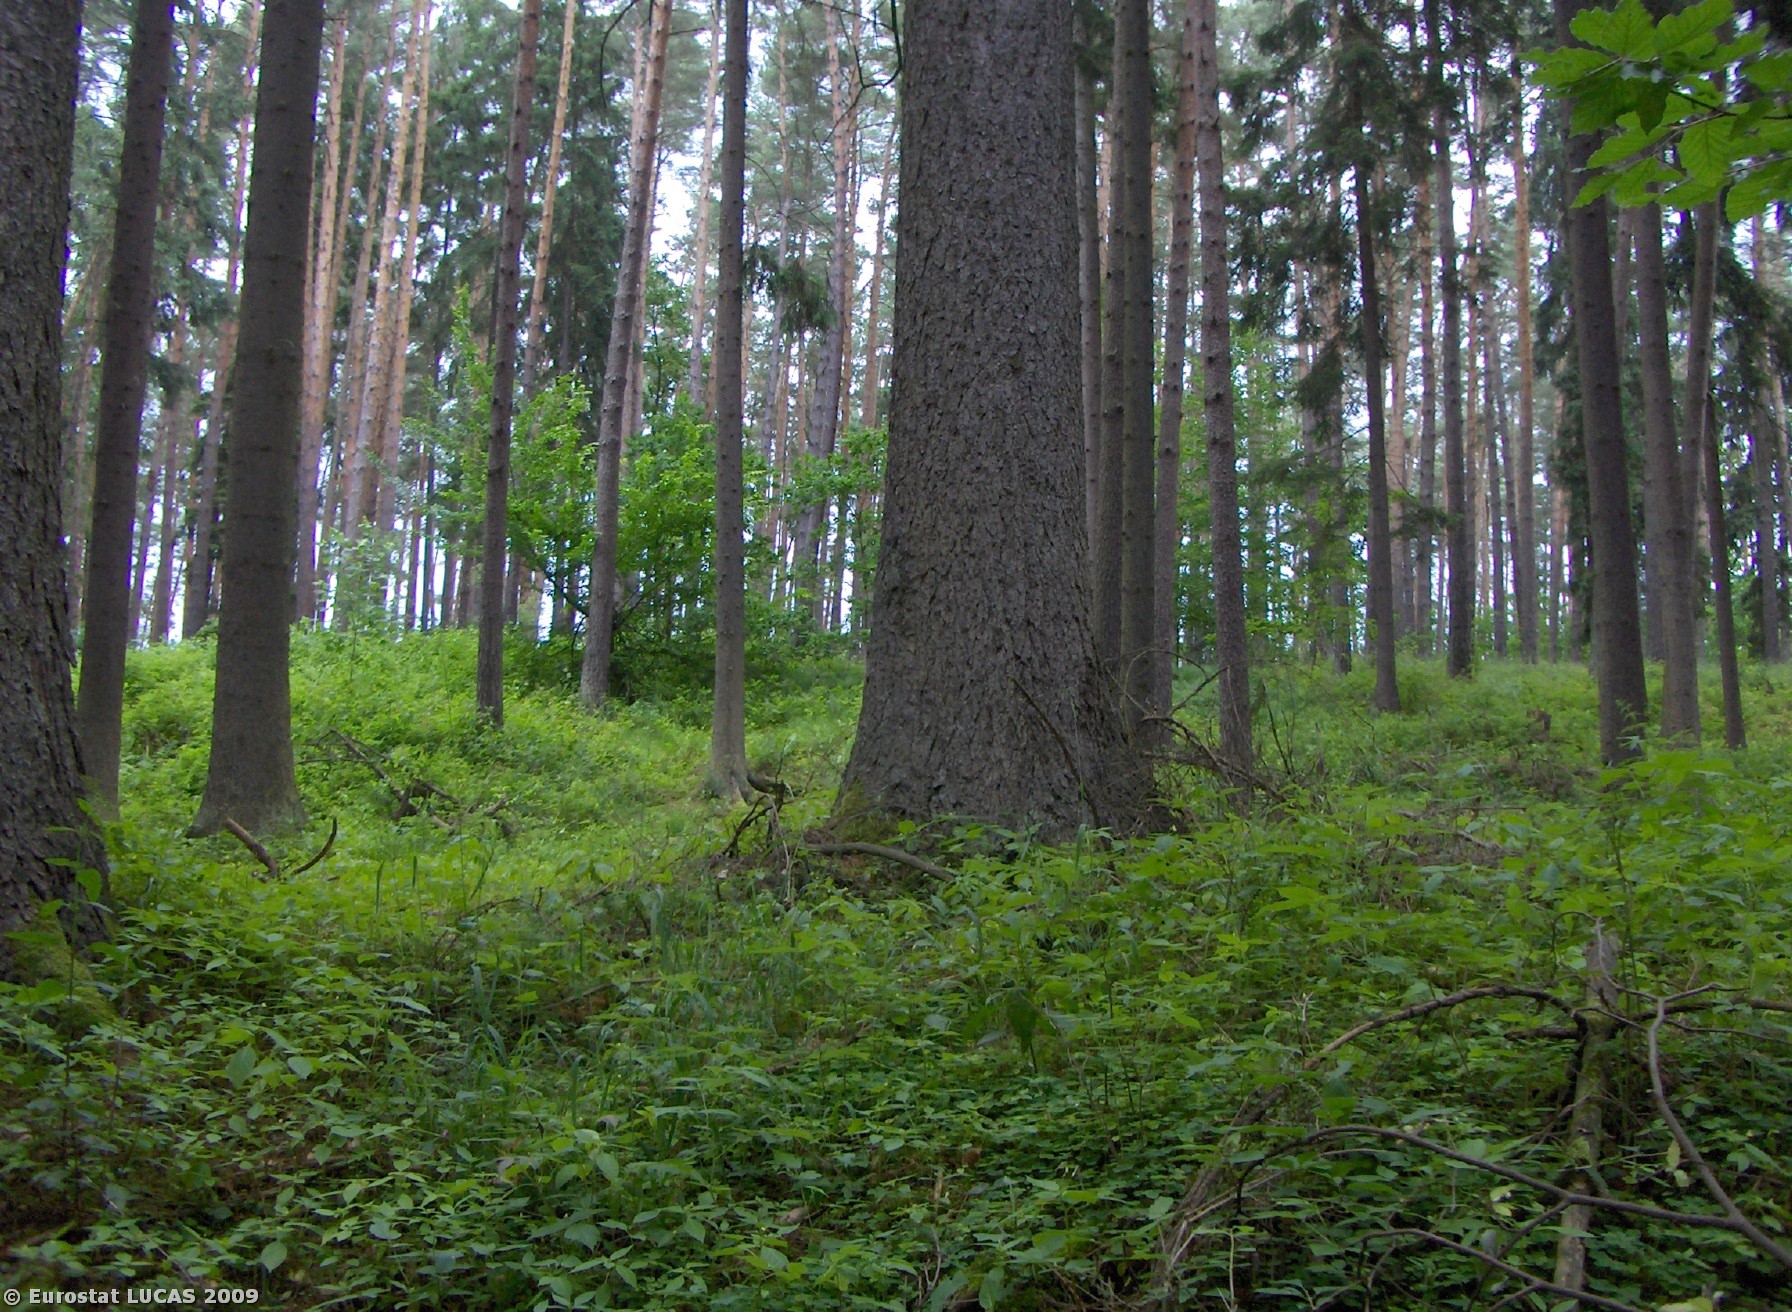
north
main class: Woodland
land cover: Coniferous woodland
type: hemiboreal forest and nemoral coniferous forest and mixed broadleaved-coniferous forest
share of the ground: > 75 %
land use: Forestry
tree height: > 5 m
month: June
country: CZ
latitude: 49.2915
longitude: 14.3322
